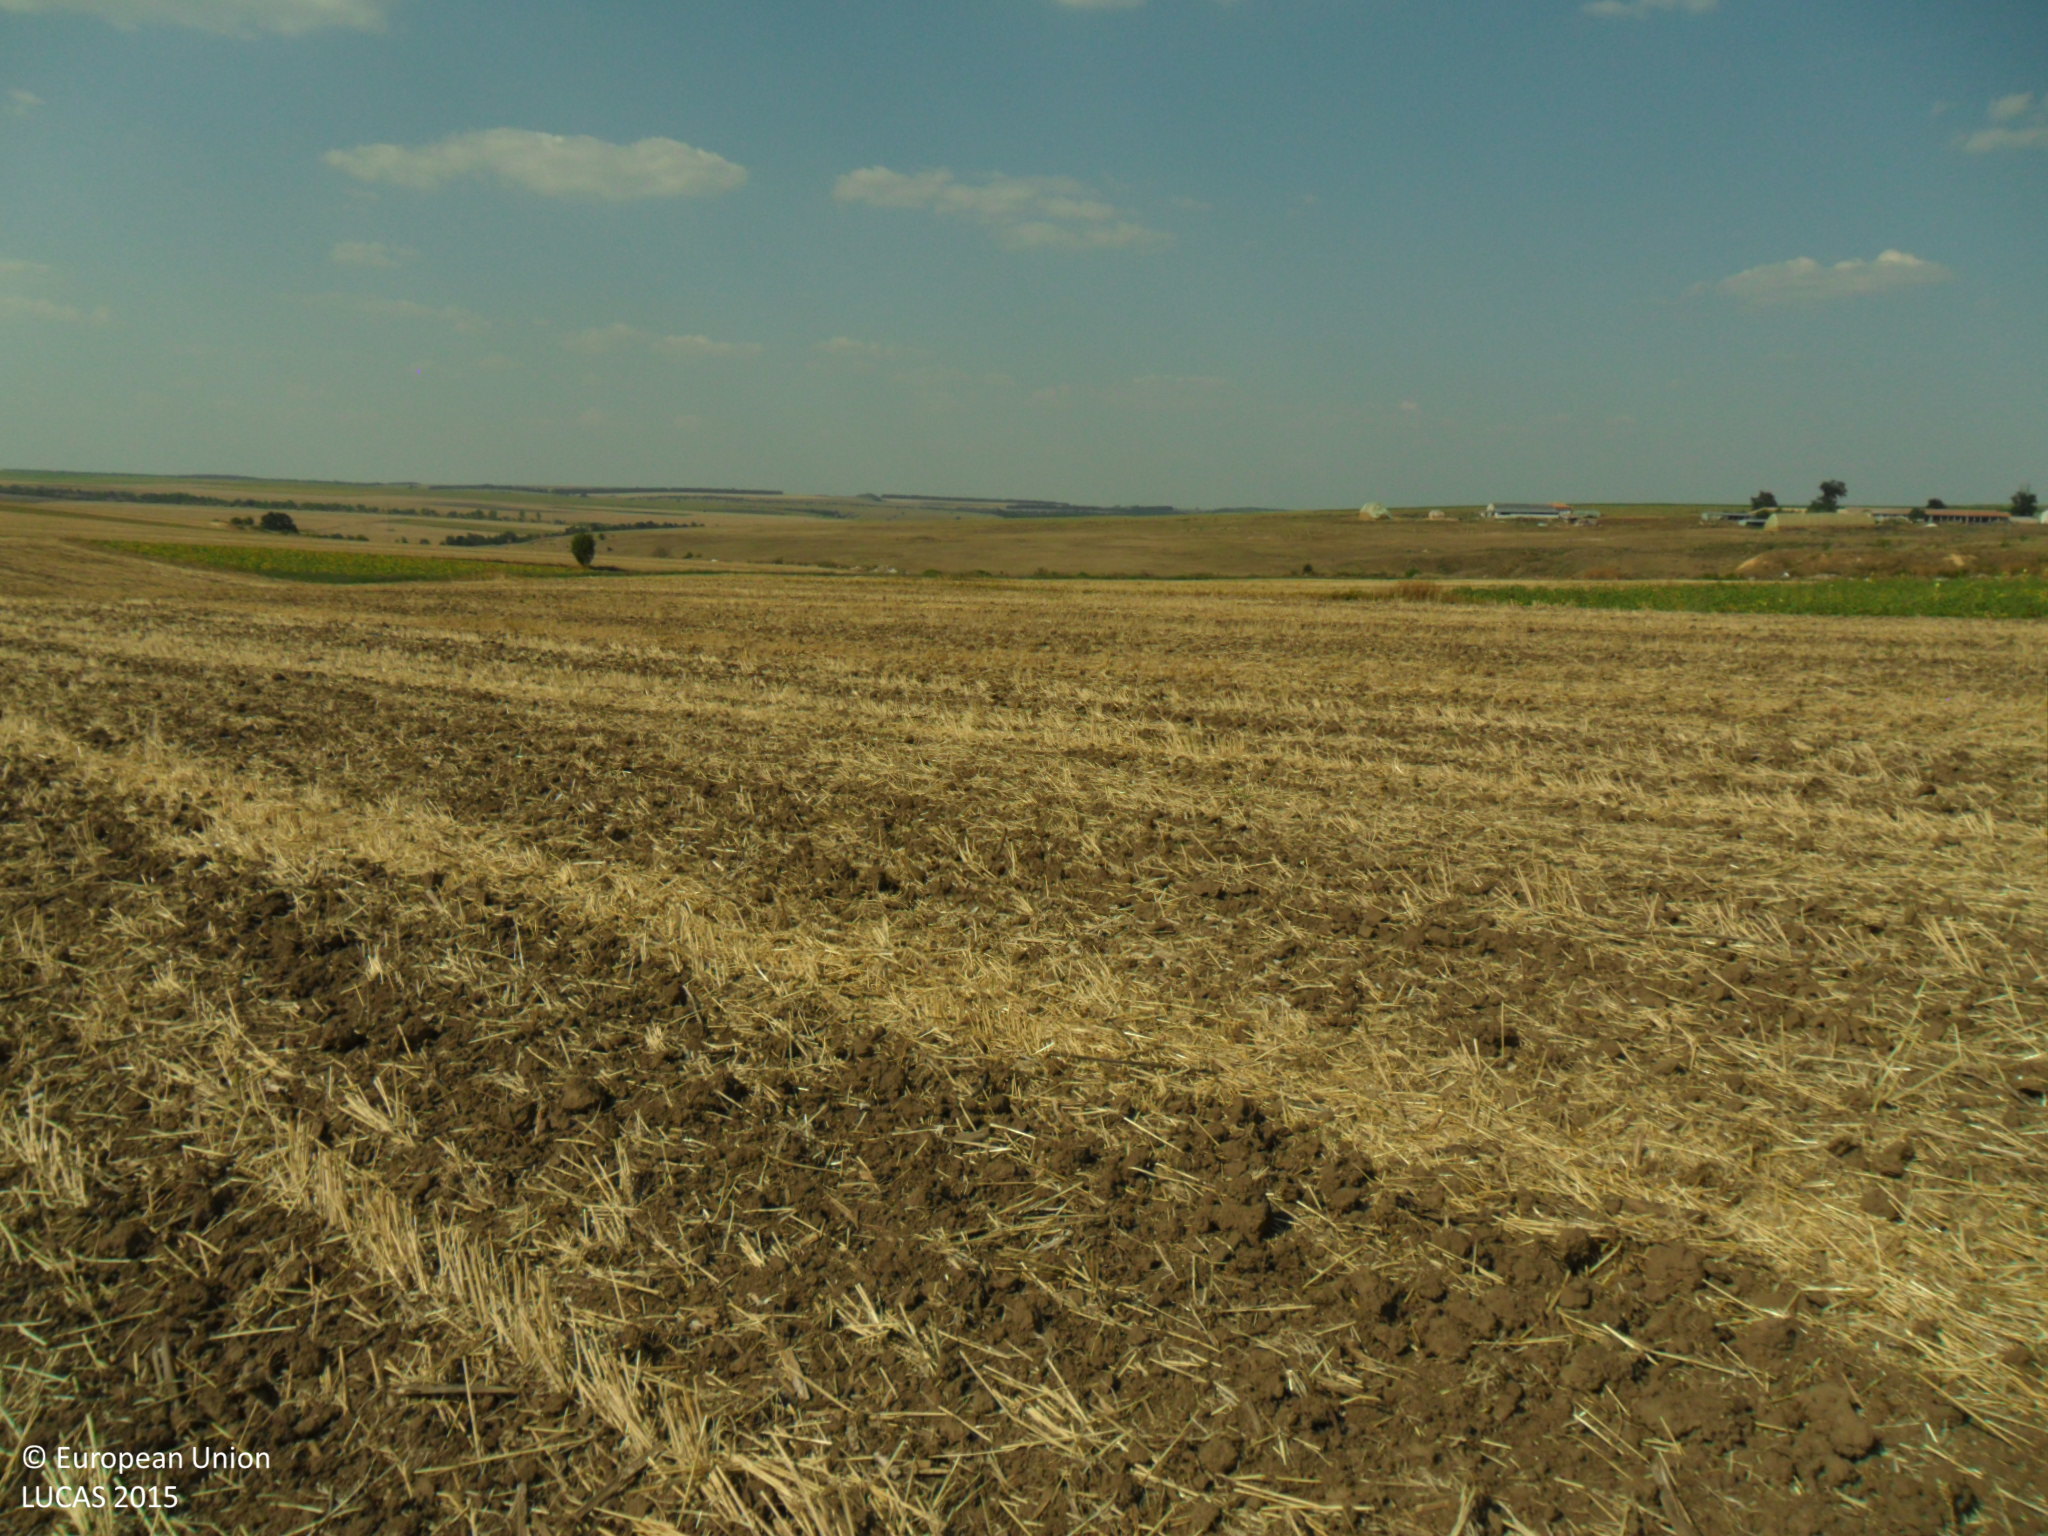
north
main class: Cropland
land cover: Common wheat
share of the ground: < 10 %
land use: Agriculture (excluding fallow land and kitchen gardens)
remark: Harvested field
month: August
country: BG
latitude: 43.6294
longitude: 27.1396
